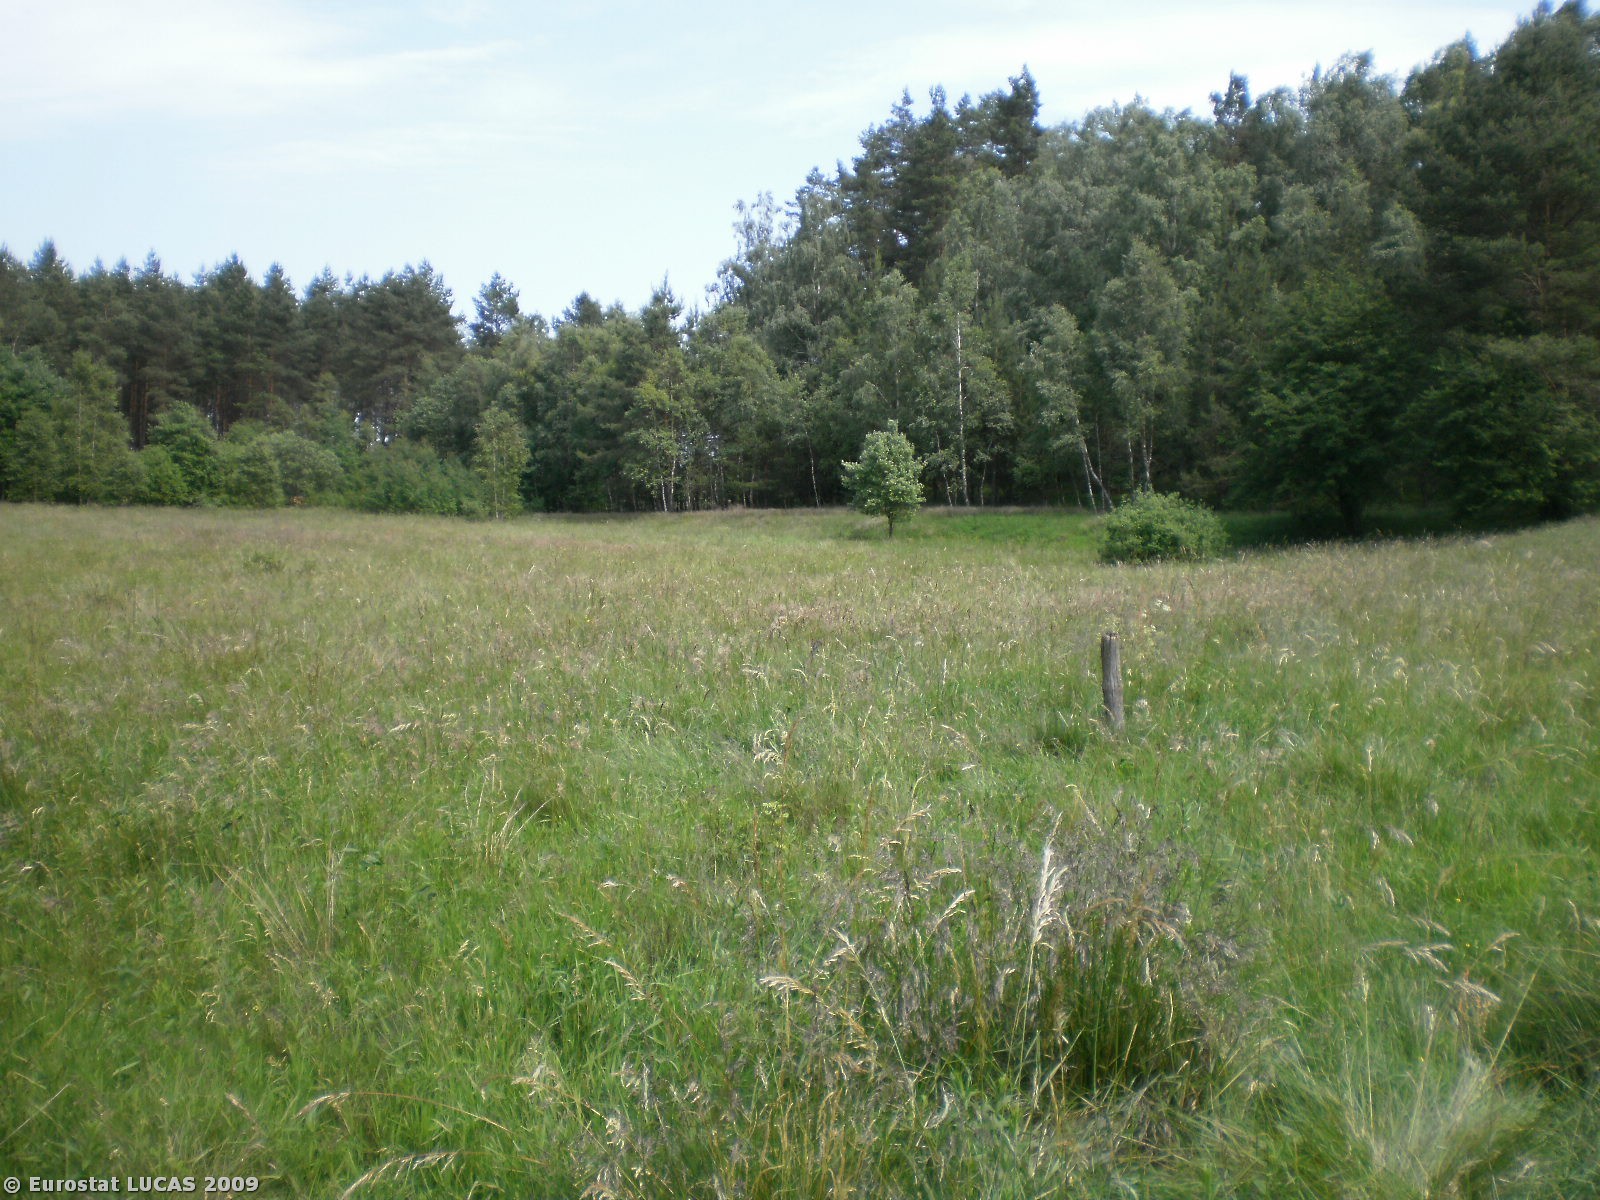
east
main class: Grassland
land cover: Grassland with sparse tree/shrub cover
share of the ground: > 75 %
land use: Agriculture (excluding fallow land and kitchen gardens)
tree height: < 5 m
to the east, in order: Grassland with sparse tree/shrub cover; Grassland without tree/shrub cover; Mixed woodland; Tracks; Mixed woodland; Tracks; Grass margins; Rye
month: June
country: PL
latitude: 54.3914
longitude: 17.2939
